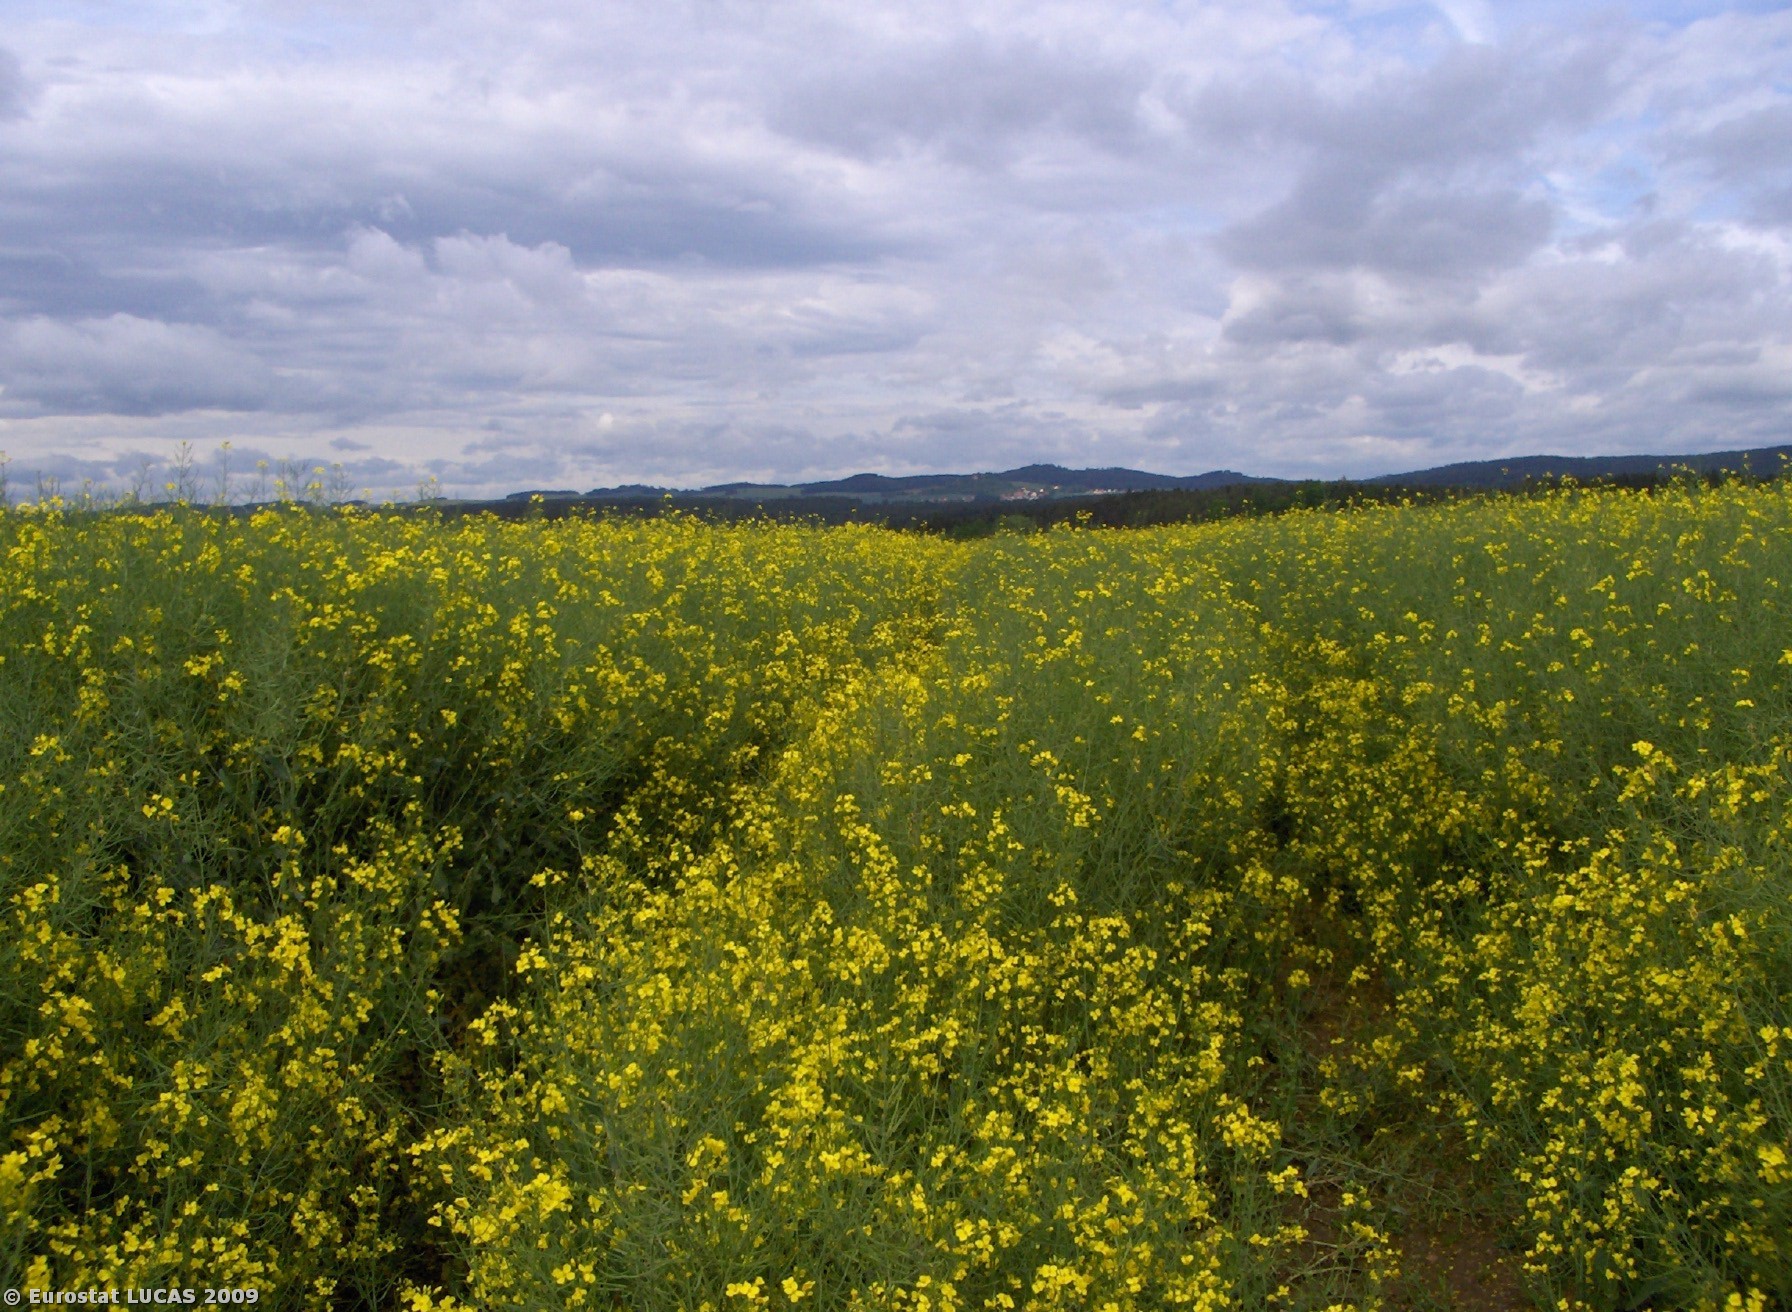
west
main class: Cropland
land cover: Rape and turnip rape
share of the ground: > 75 %
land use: Agriculture (excluding fallow land and kitchen gardens)
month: May
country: CZ
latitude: 49.3516
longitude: 14.1720
